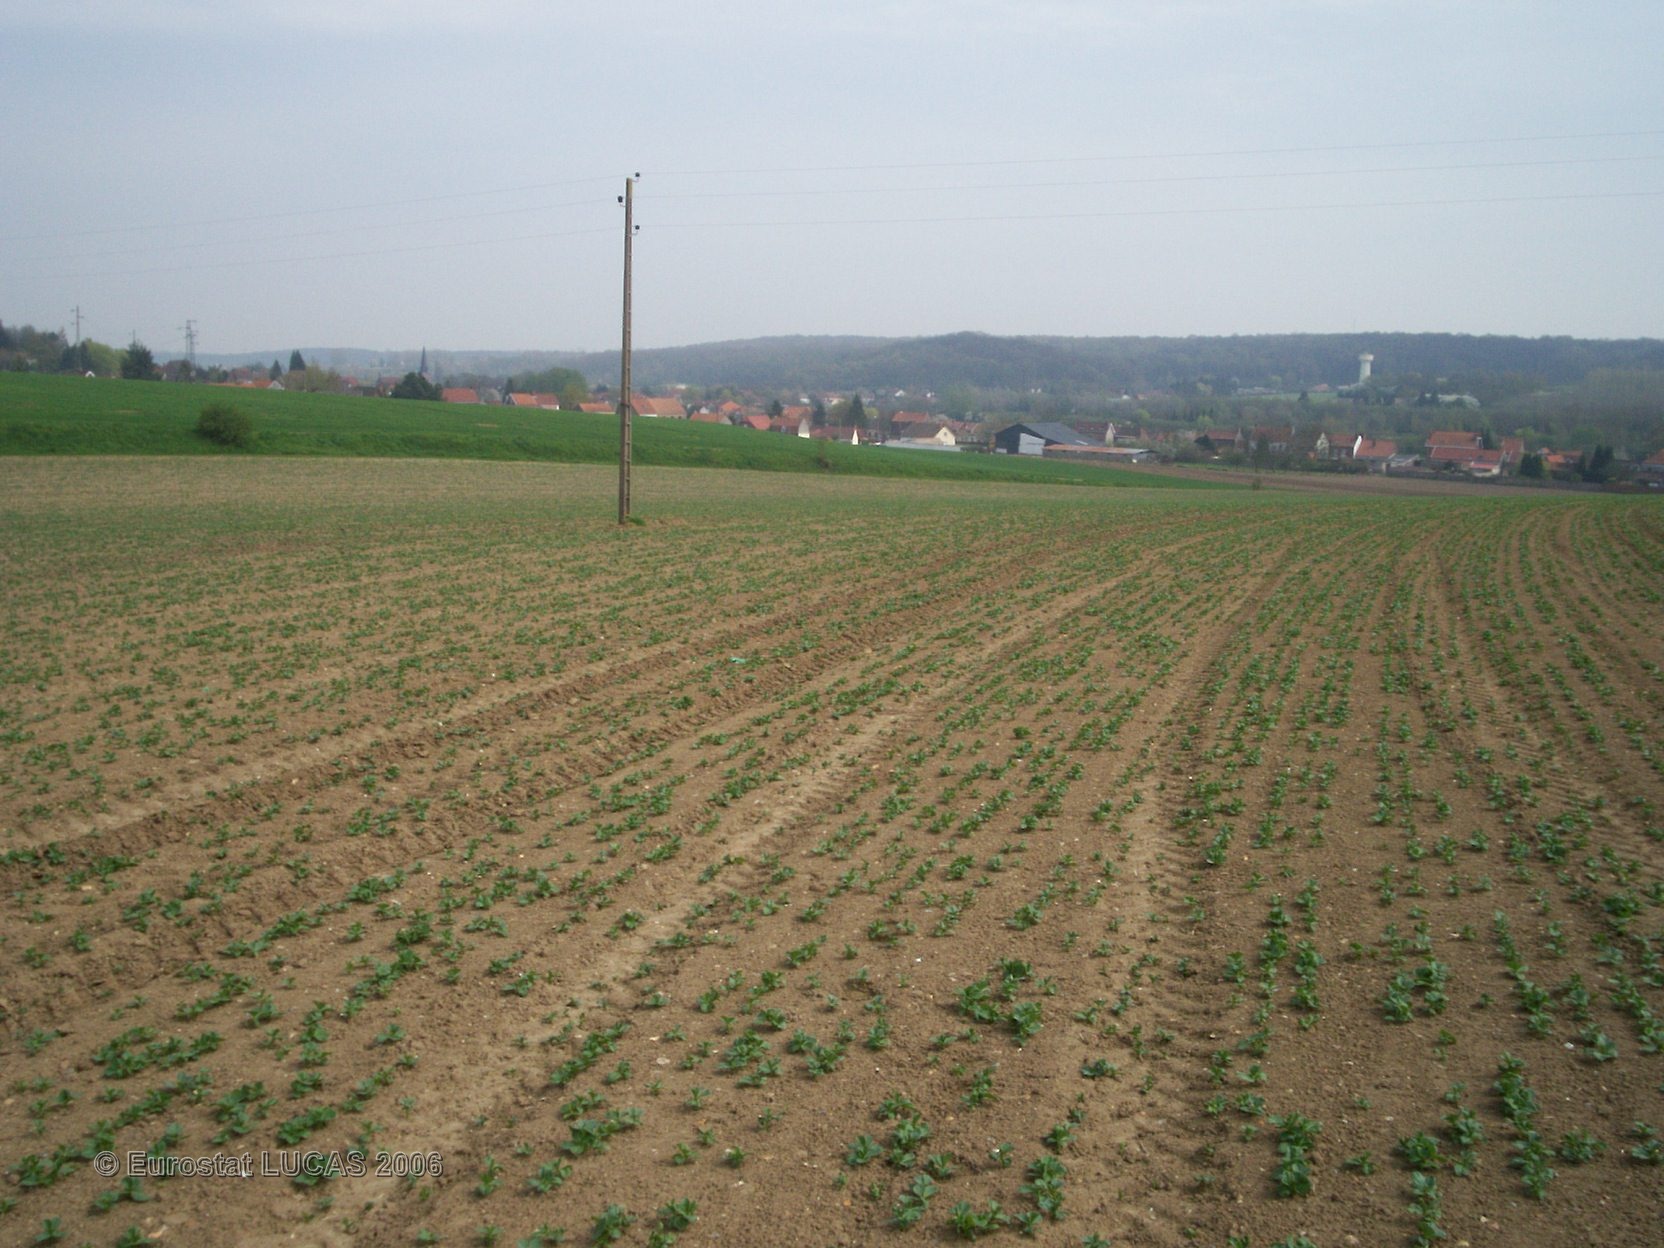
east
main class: Cropland
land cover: Sugar beet
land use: Agriculture (excluding fallow land and kitchen gardens)
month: April
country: FR
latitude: 50.5167
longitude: 2.5268
